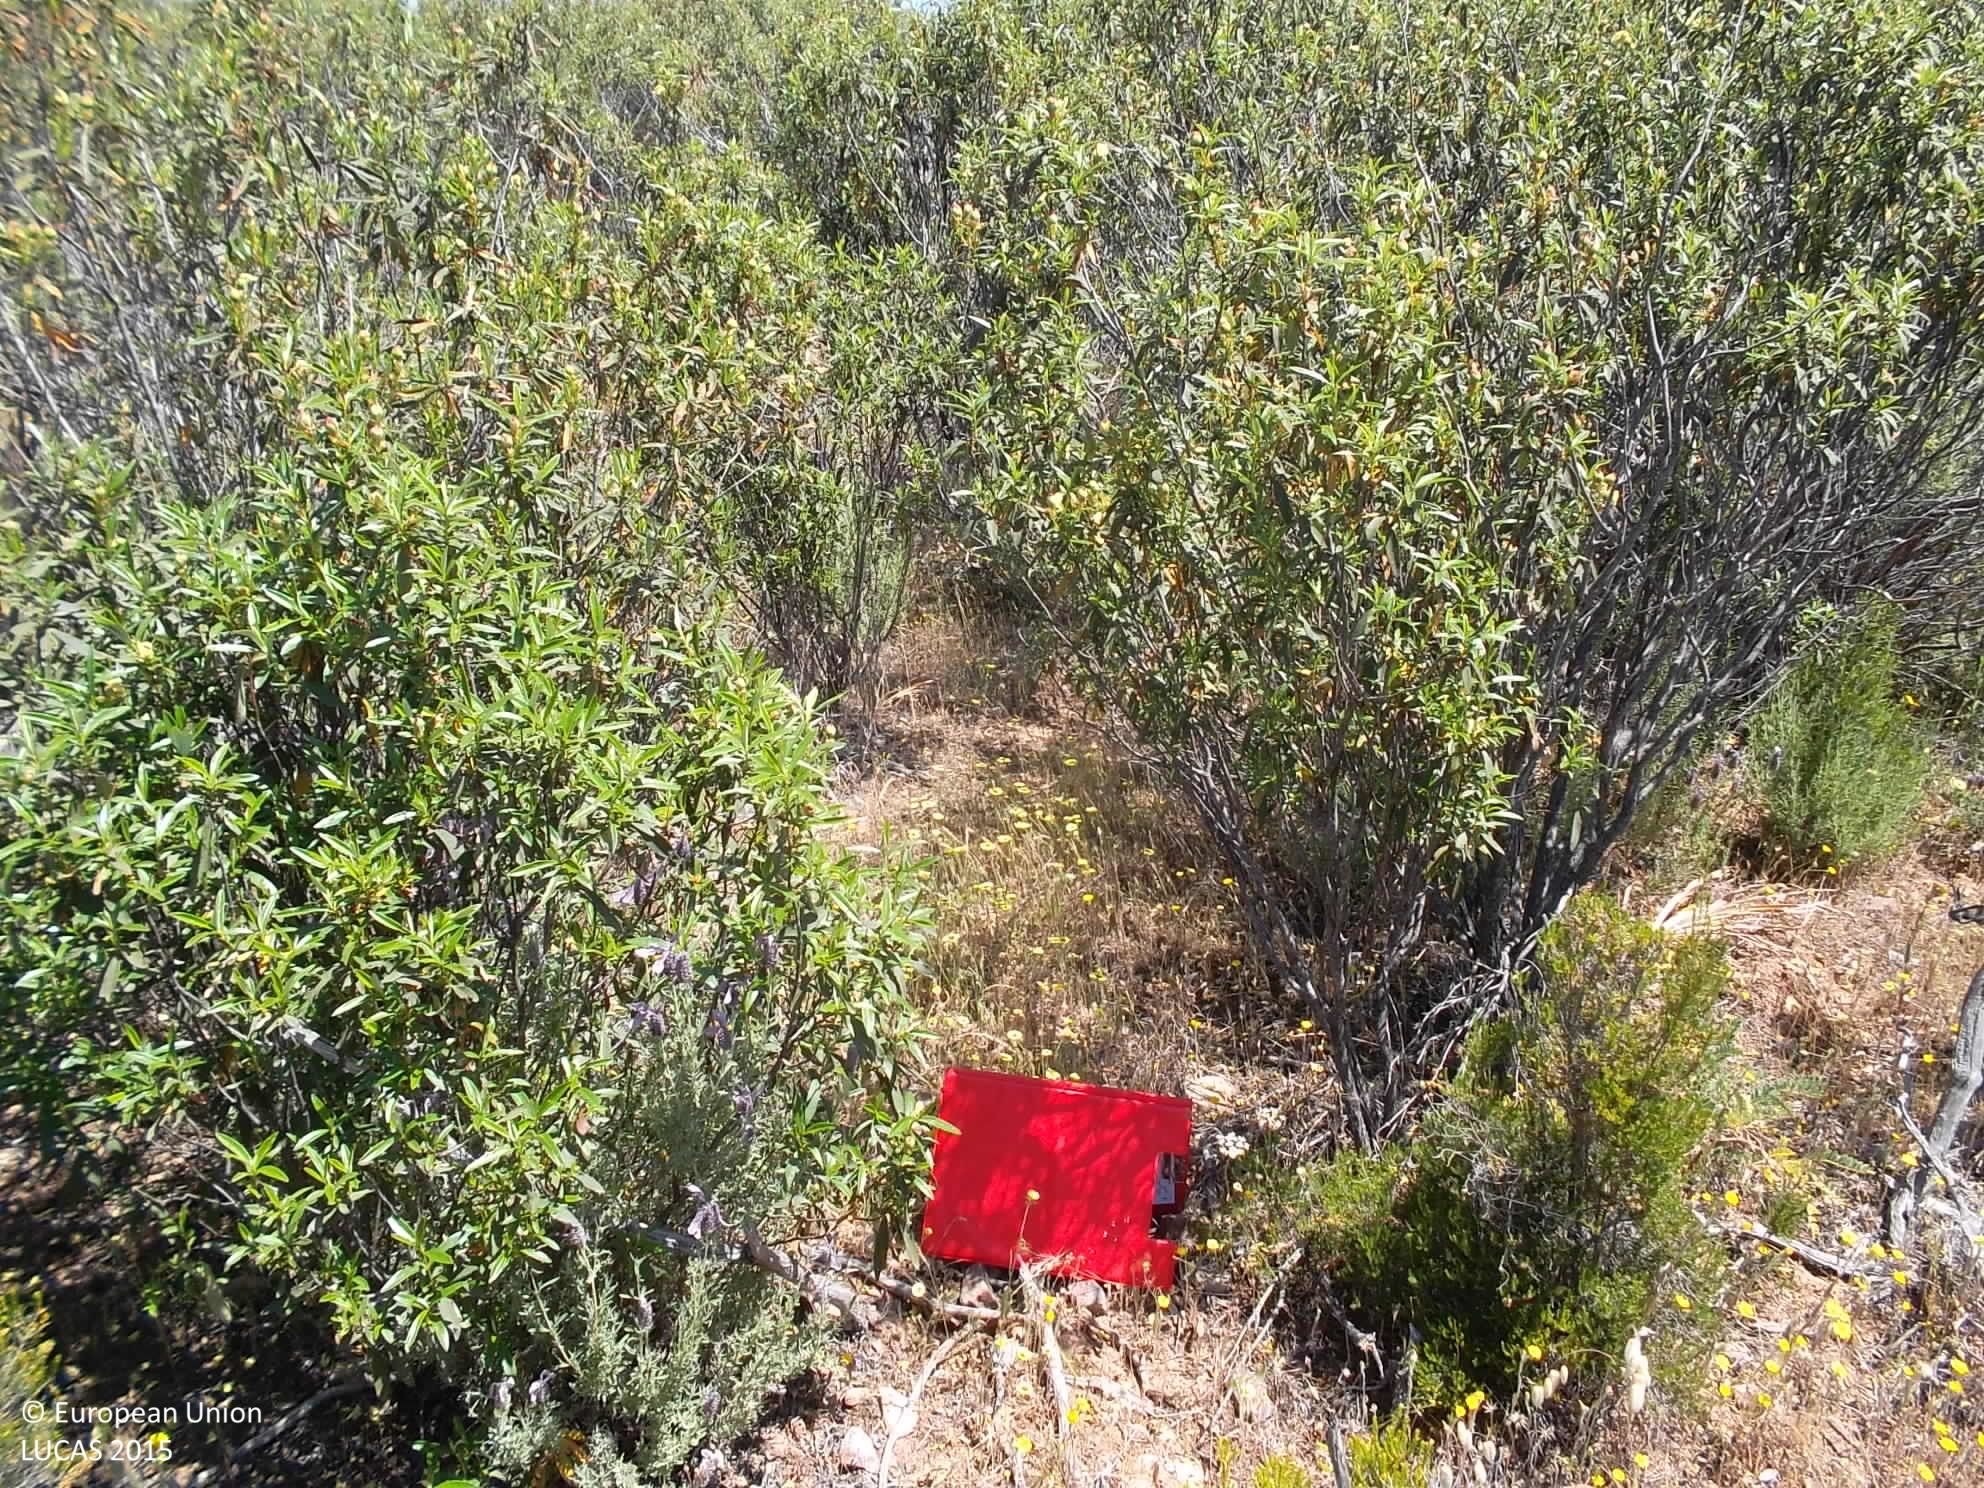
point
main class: Shrubland
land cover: Shrubland with sparse tree cover
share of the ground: > 75 %
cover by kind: shrubs 95 %, broadleaved forest trees 5 %
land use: Forestry
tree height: < 5 m
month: May
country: ES
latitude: 38.5211
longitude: -4.3910
